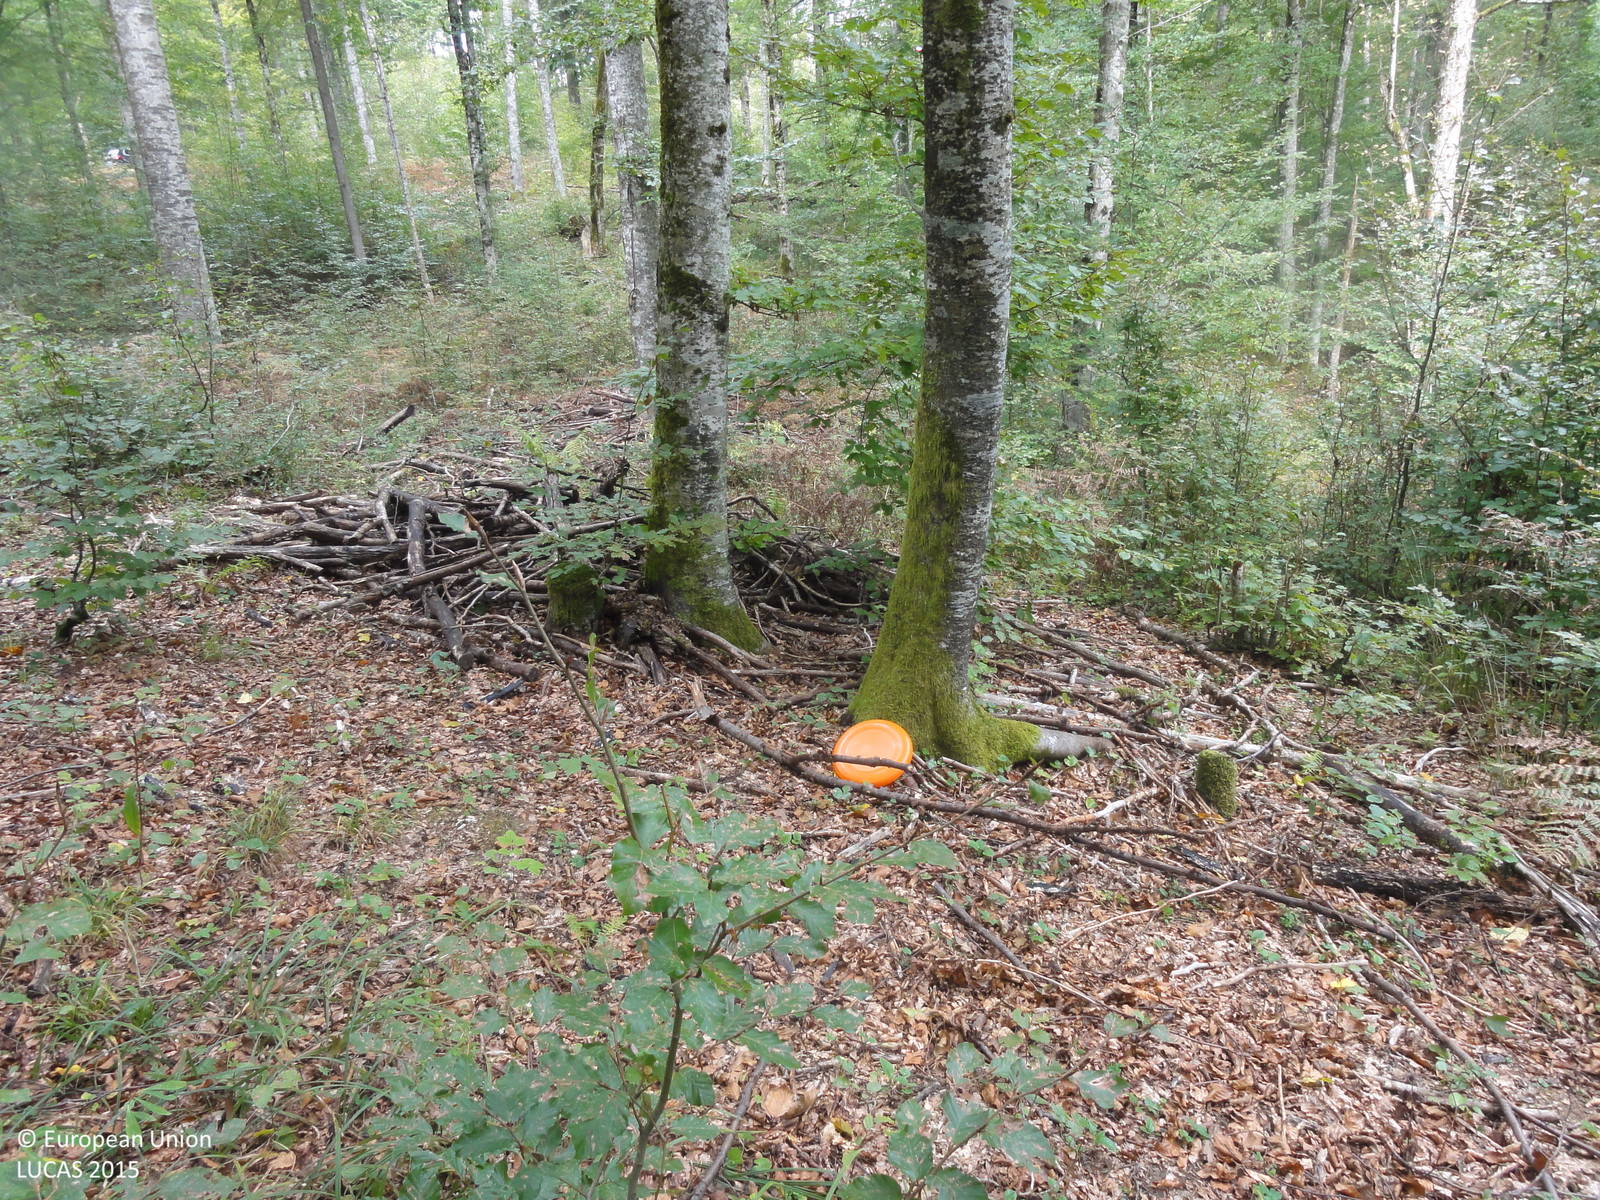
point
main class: Woodland
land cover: Broadleaved woodland
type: beech forest
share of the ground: > 75 %
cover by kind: broadleaved forest trees 85 %, shrubs 5 %, herbaceous plants 5 %
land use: Forestry
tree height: > 5 m
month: September
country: SI
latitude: 45.5495
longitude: 14.9784
